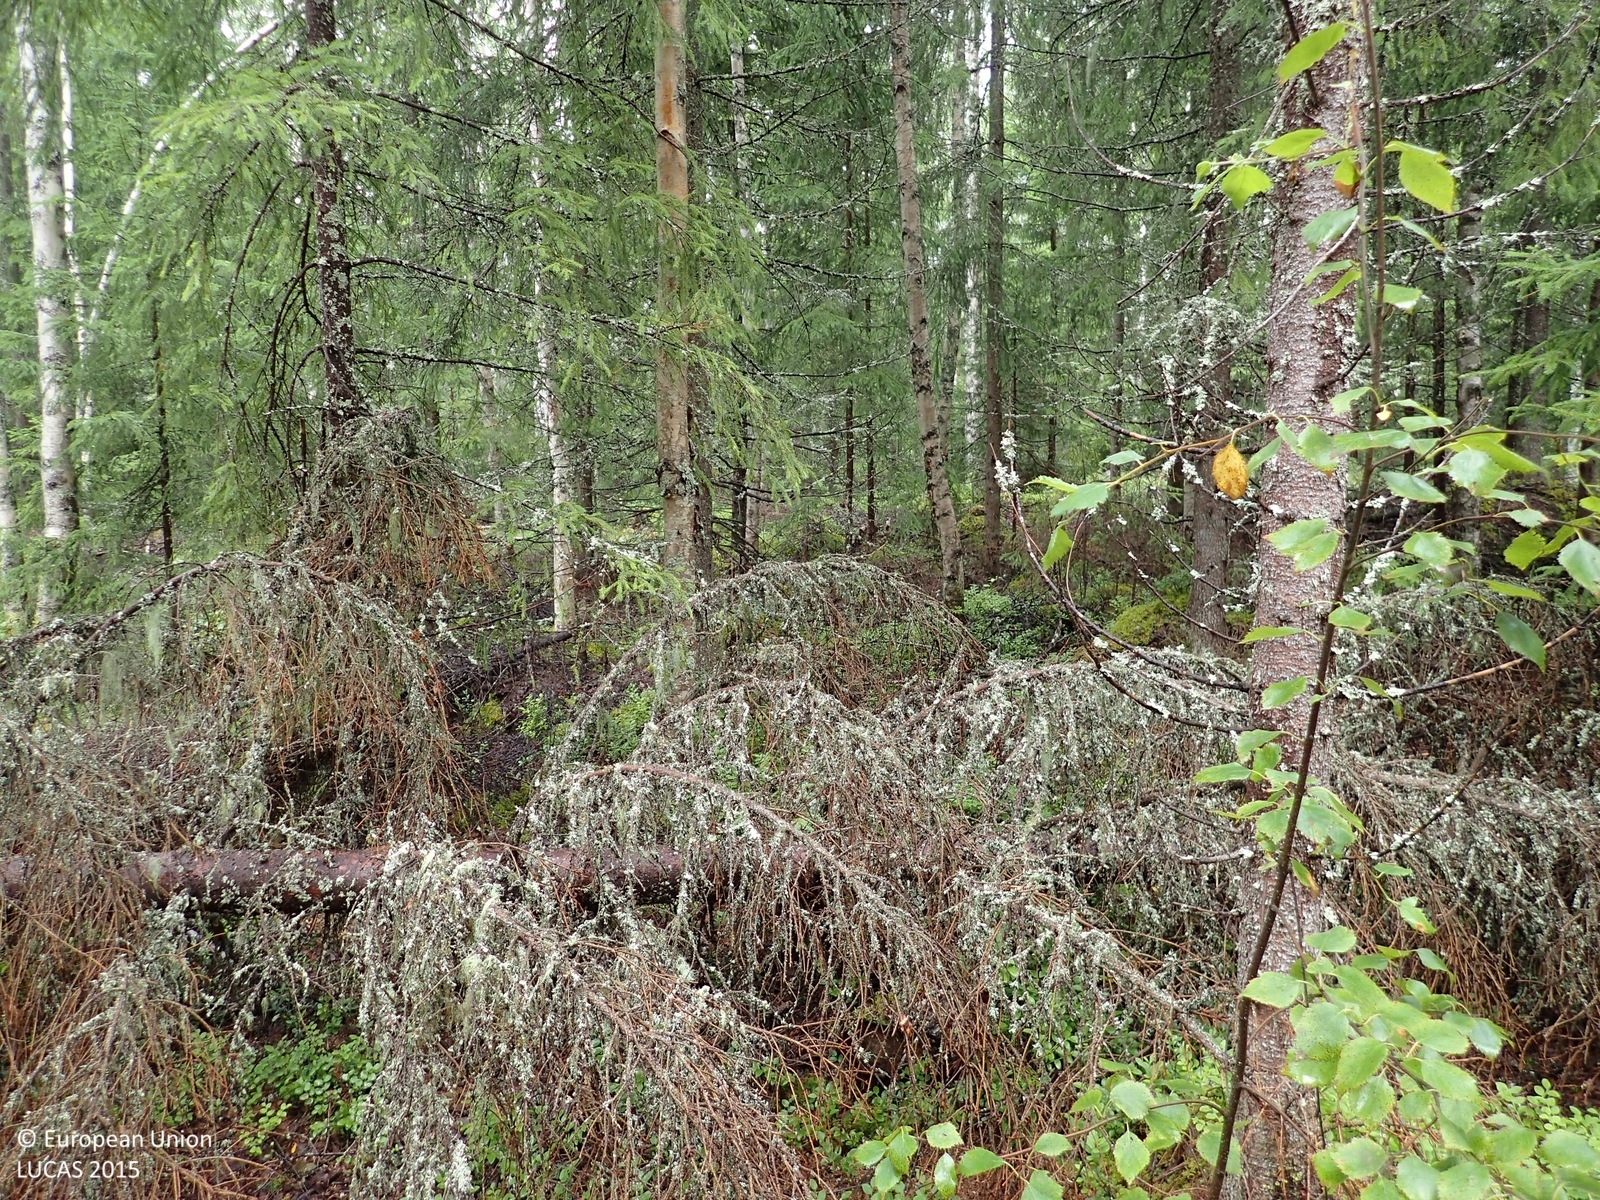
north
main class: Woodland
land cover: Spruce dominated mixed woodland
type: boreal forest
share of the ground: > 75 %
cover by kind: coniferous forest trees 55 %, broadleaved forest trees 20 %, shrubs 15 %, herbaceous plants 5 %, lichens and mosses 5 %
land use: Forestry
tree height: > 5 m
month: July
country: FI
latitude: 62.9774
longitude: 22.8205
